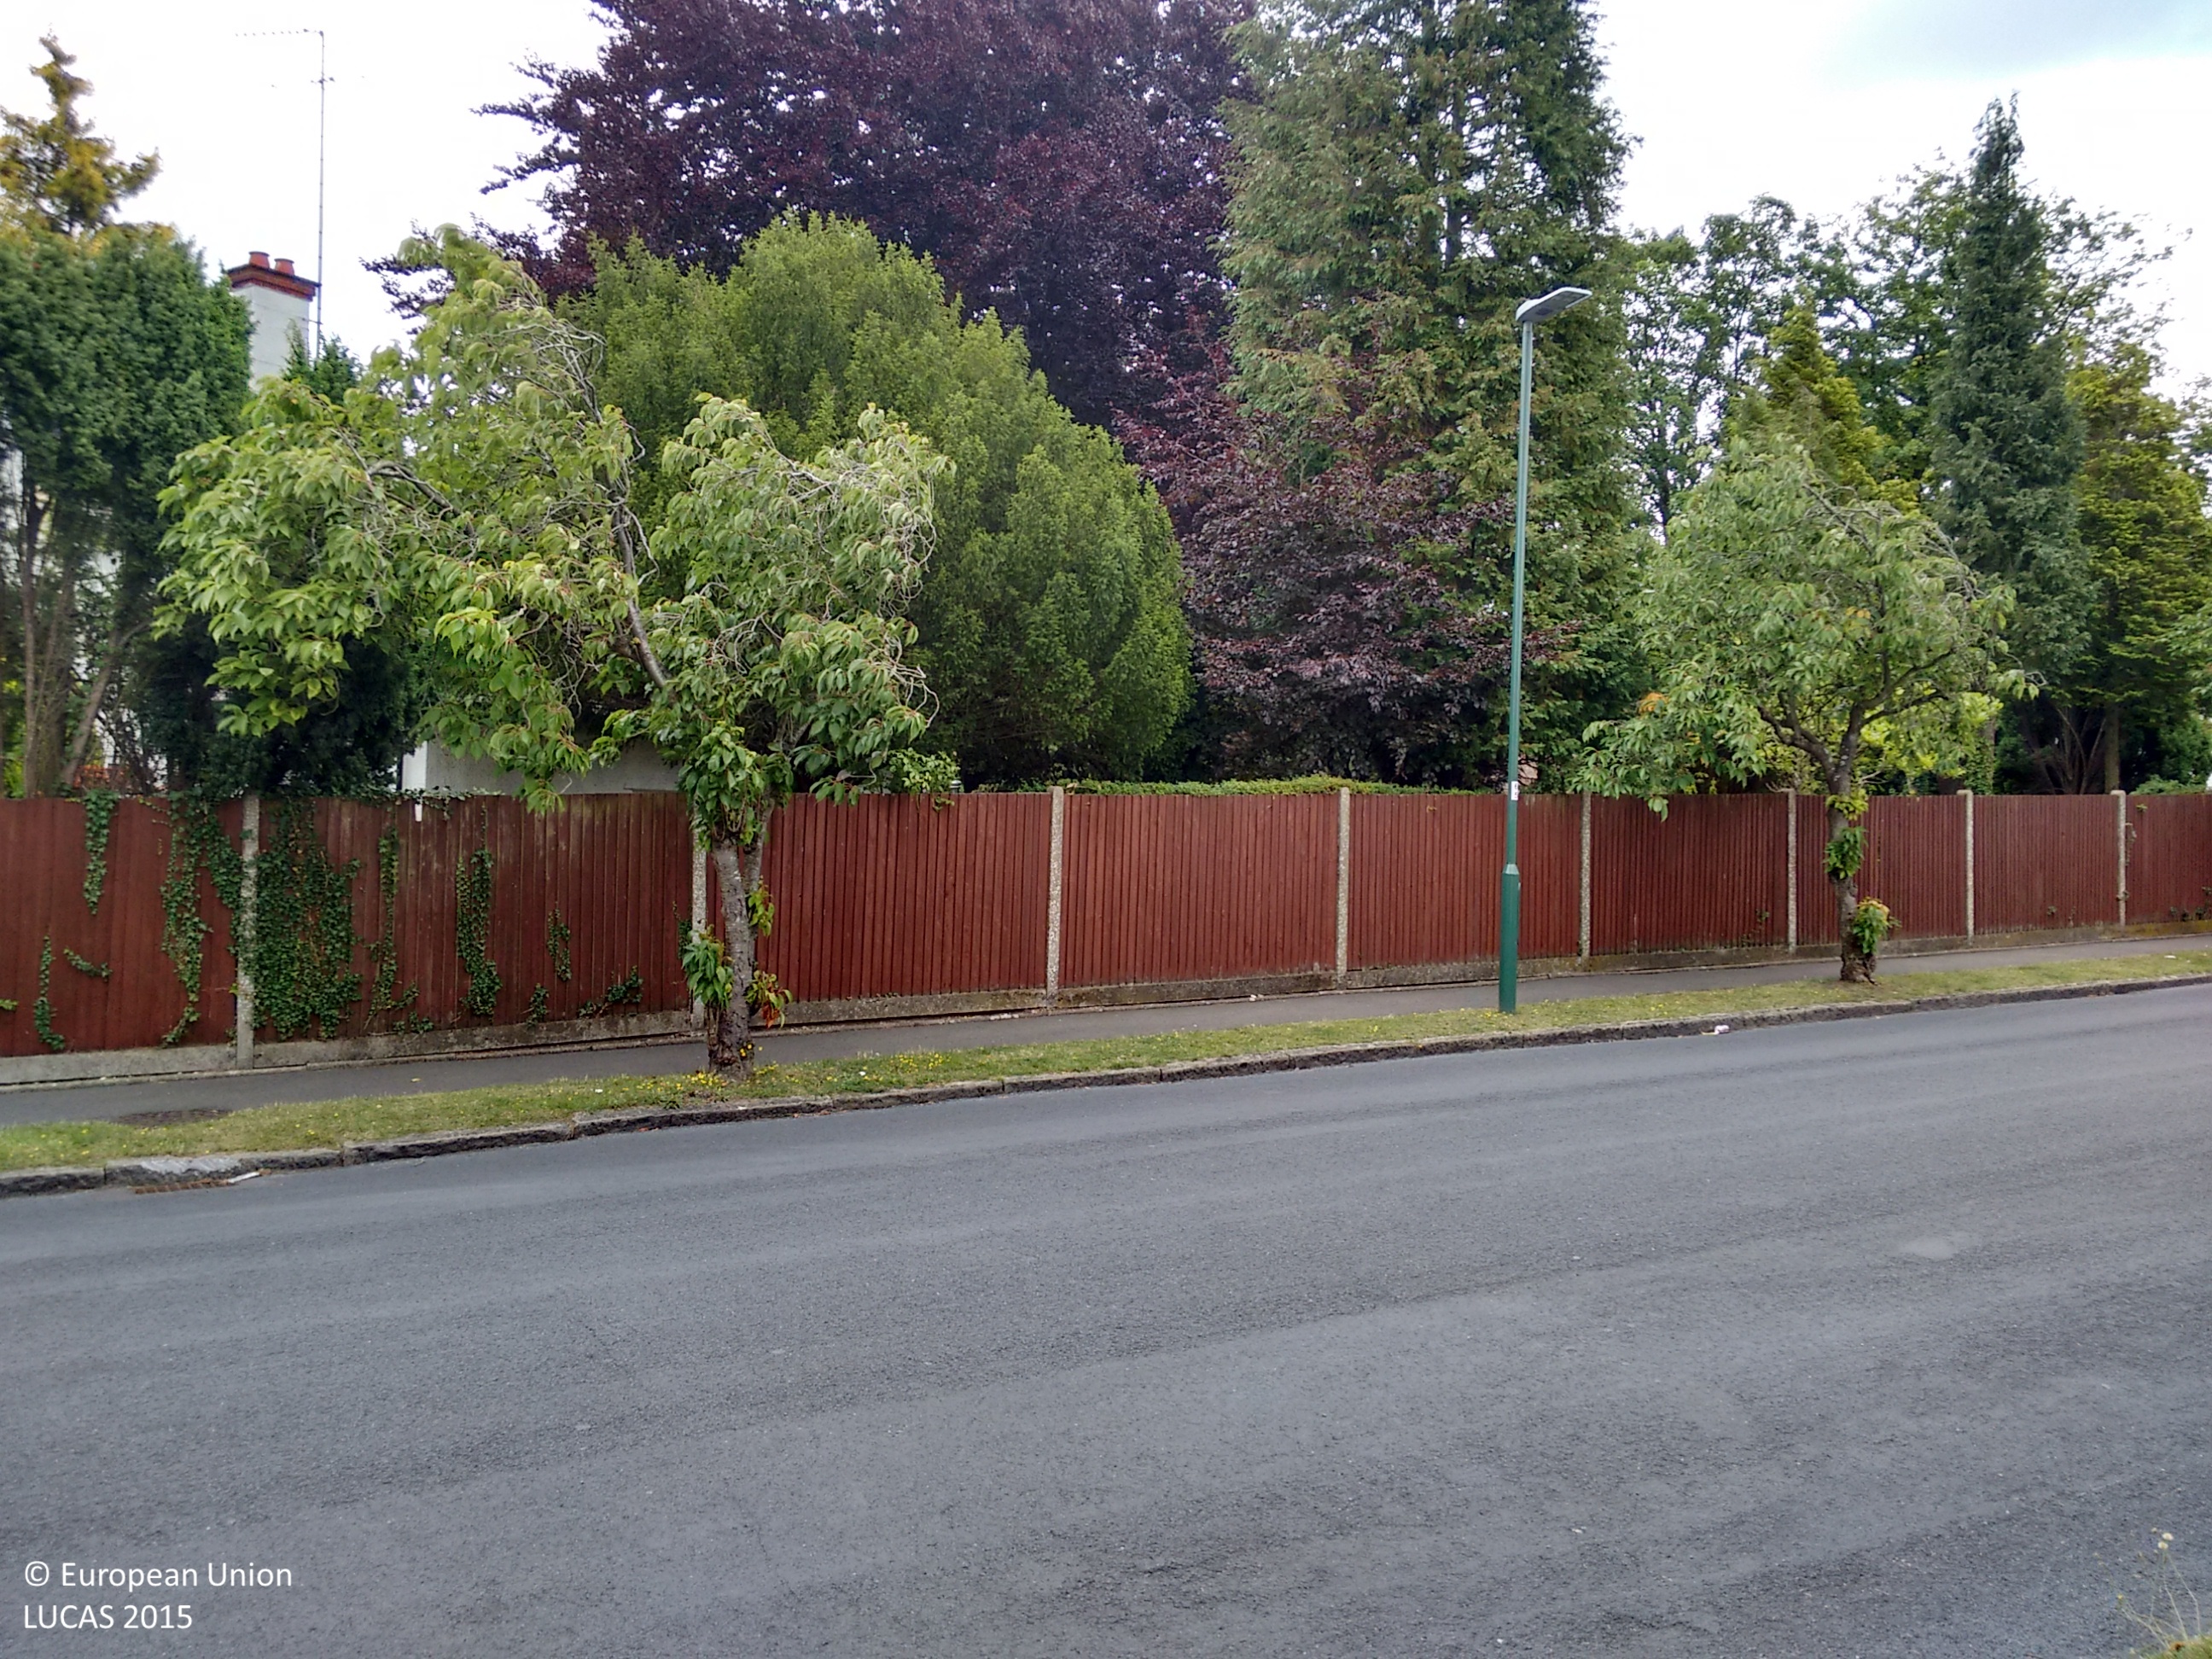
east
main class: Grassland
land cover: Grassland with sparse tree/shrub cover
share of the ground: > 75 %
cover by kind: herbaceous plants 95 %, coniferous forest trees 5 %
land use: Residential
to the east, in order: Grassland with sparse tree/shrub cover; Artificial constructions in urban areas
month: August
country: GB
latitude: 51.3377
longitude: -0.2124
